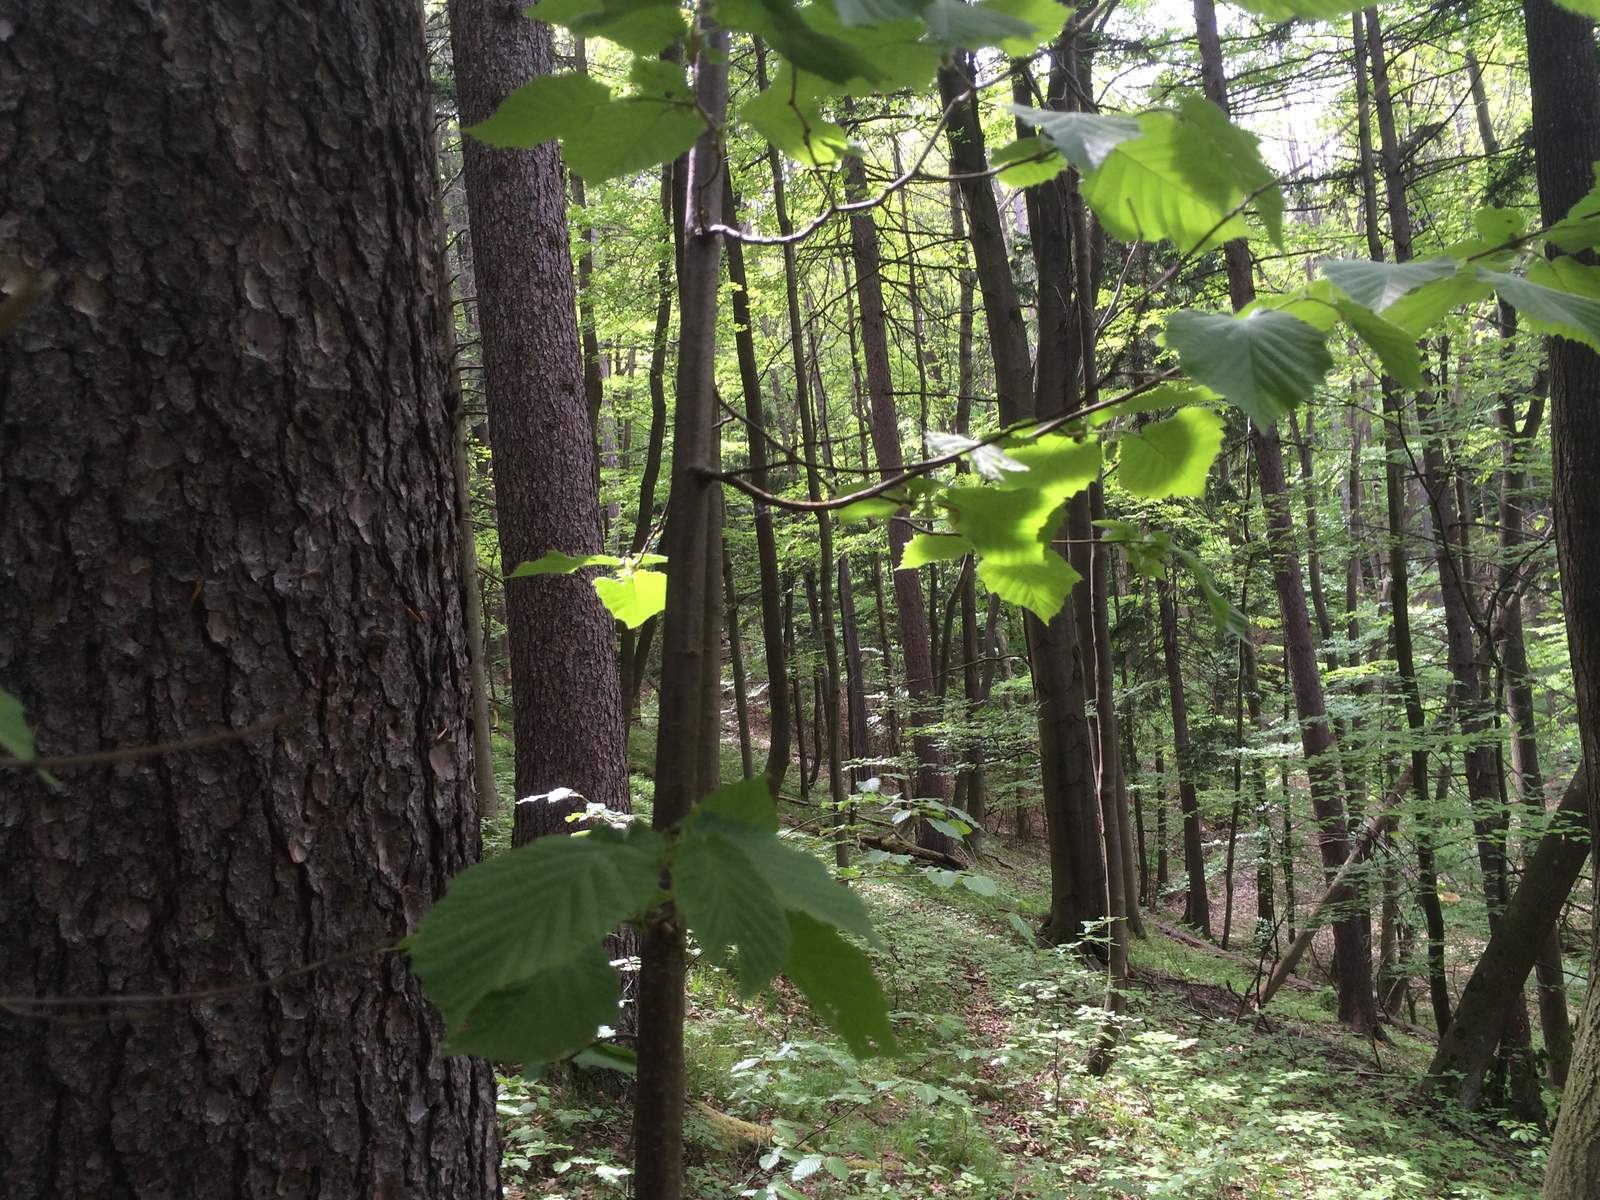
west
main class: Woodland
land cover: Other mixed woodland
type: alpine coniferous forest
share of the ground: > 75 %
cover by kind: broadleaved forest trees 60 %, coniferous forest trees 40 %
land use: Forestry
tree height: > 5 m
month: May
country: AT
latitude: 47.9078
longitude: 16.1445
